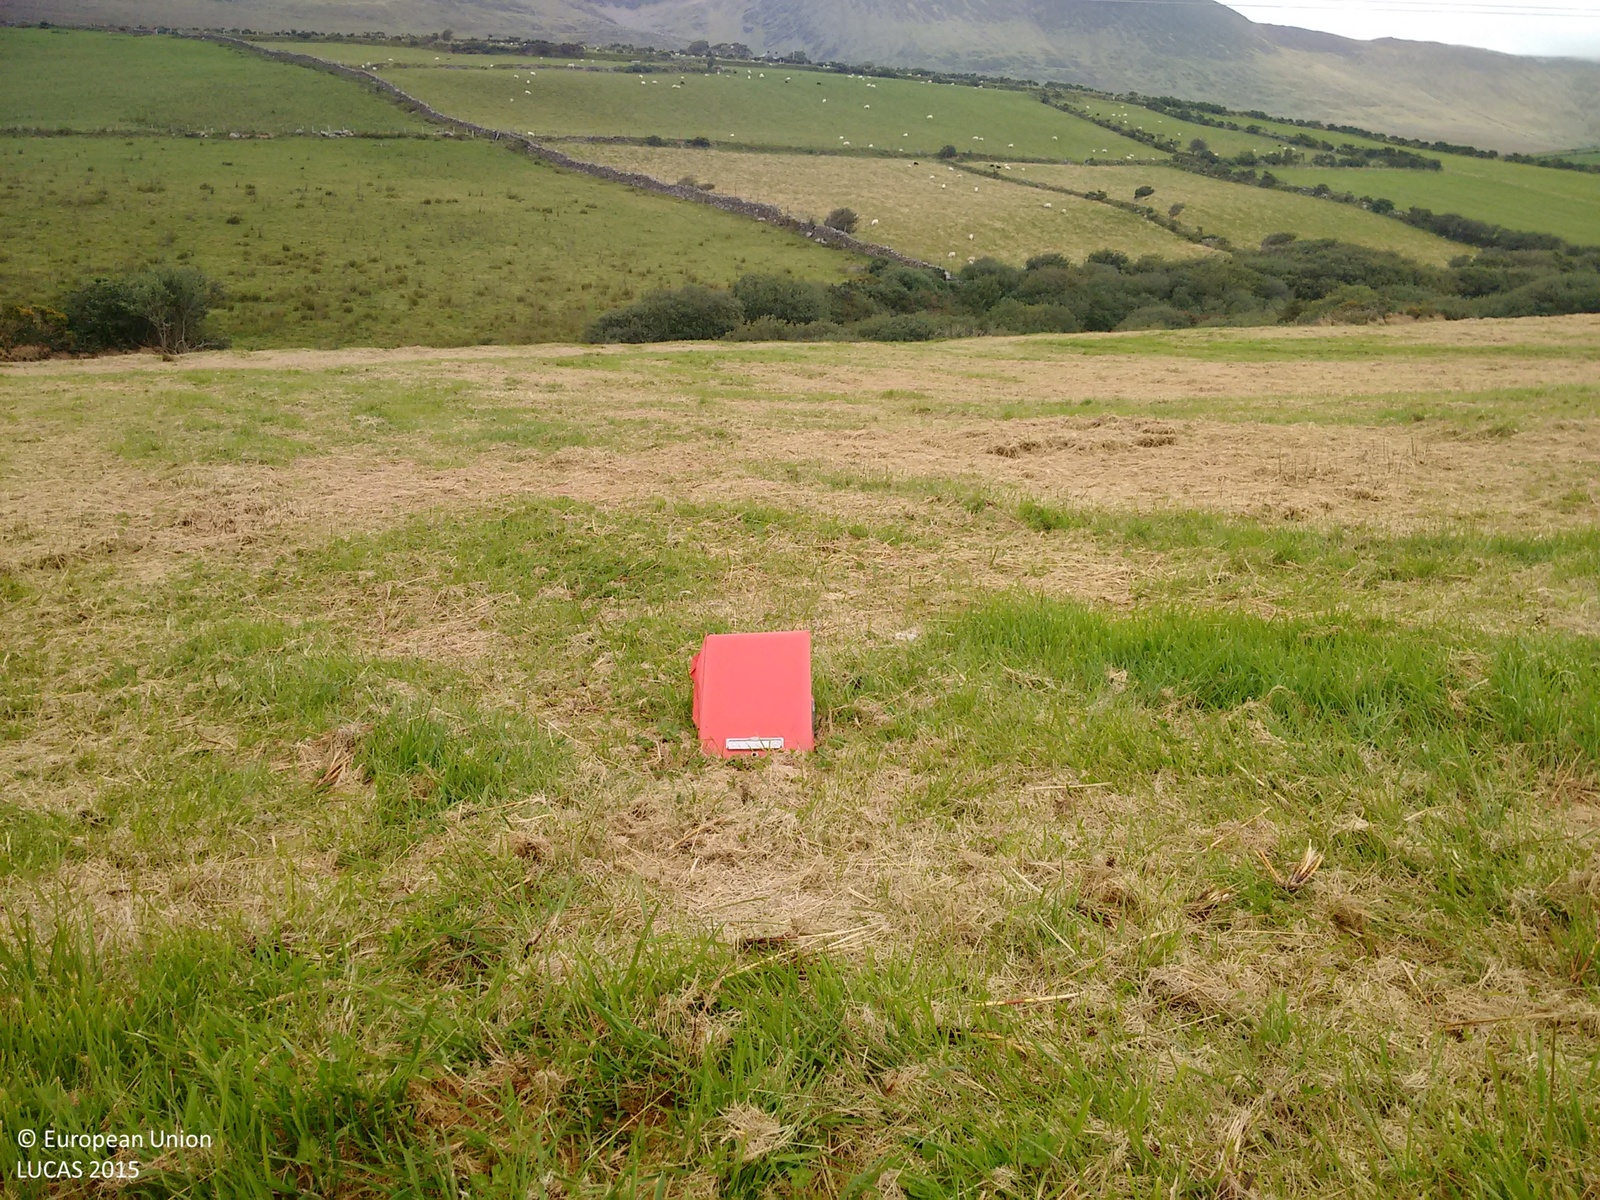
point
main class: Grassland
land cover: Grassland without tree/shrub cover
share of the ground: > 75 %
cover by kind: herbaceous plants 100 %
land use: Agriculture (excluding fallow land and kitchen gardens)
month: September
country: IE
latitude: 52.1449
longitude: -10.1491
